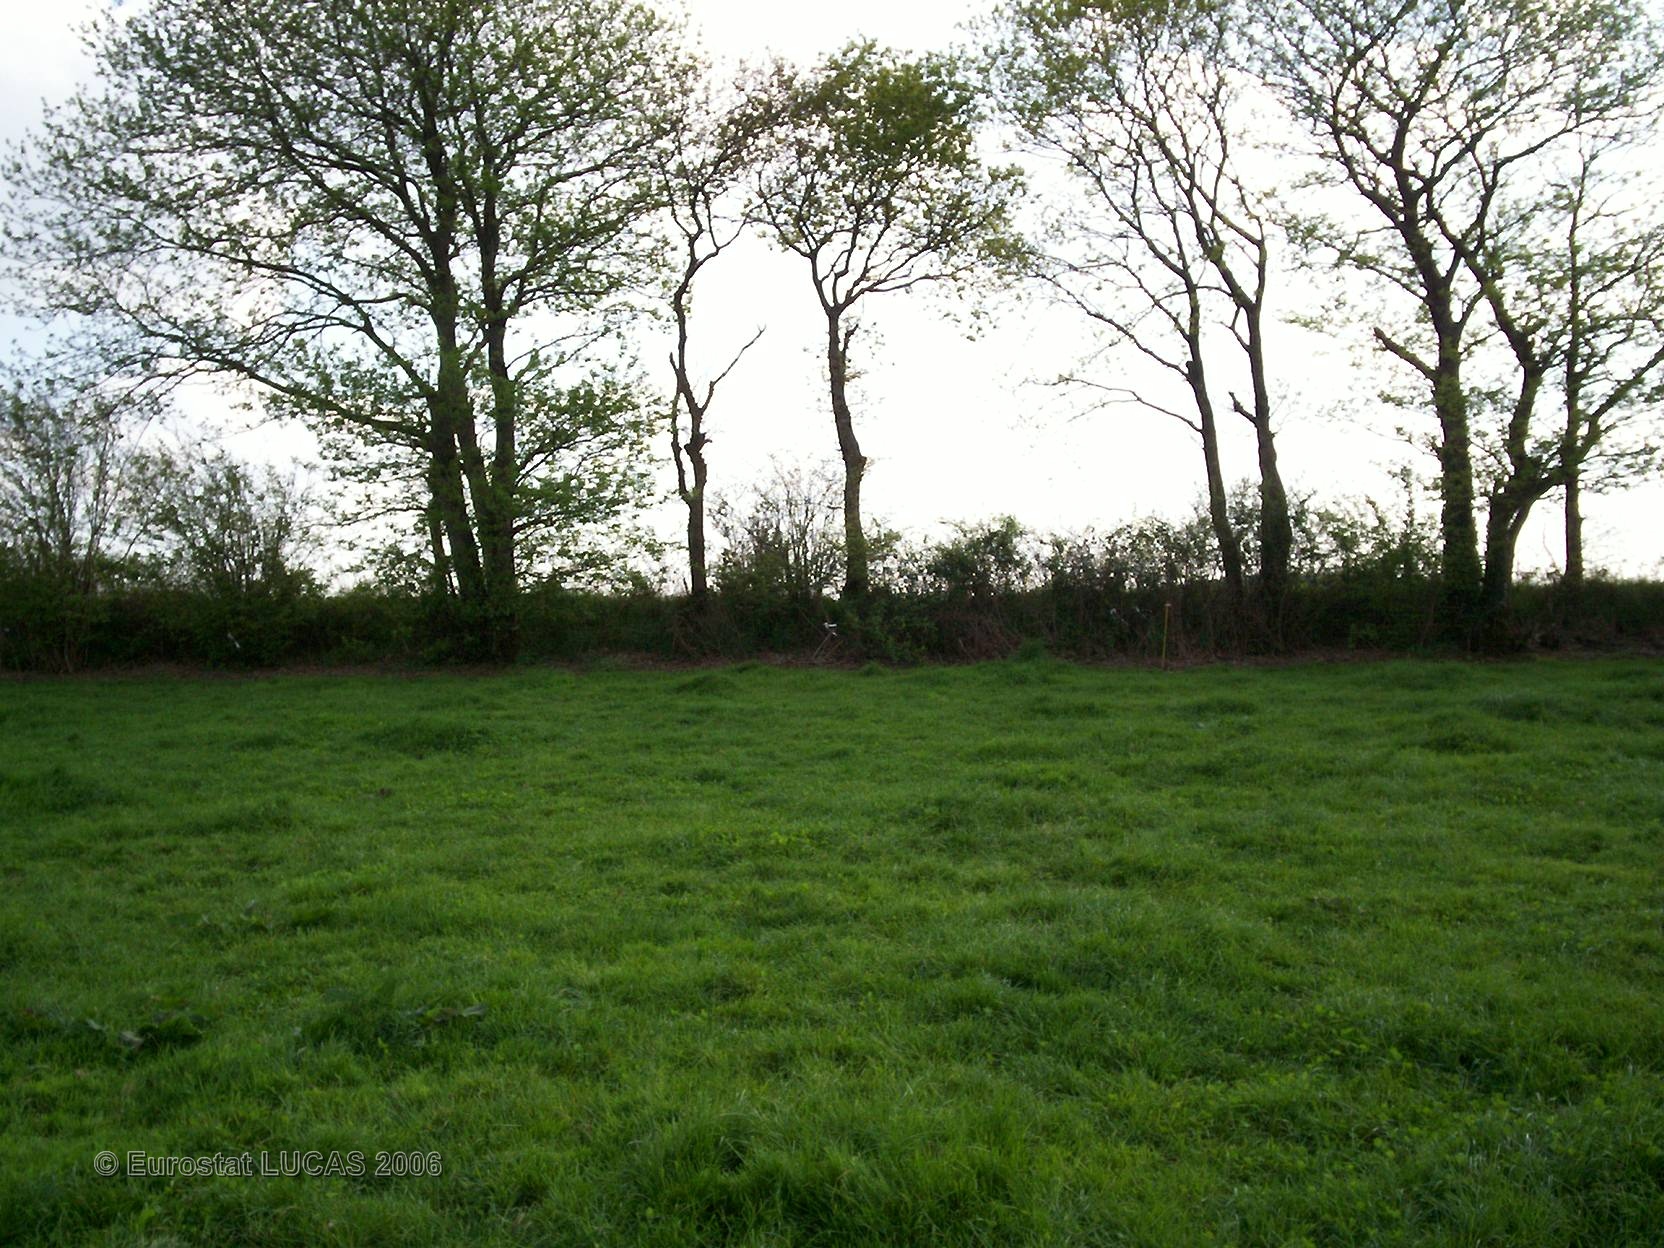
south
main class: Grassland
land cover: Grassland without tree/shrub cover
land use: Agriculture (excluding fallow land and kitchen gardens)
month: May
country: FR
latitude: 48.3413
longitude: -3.6125
